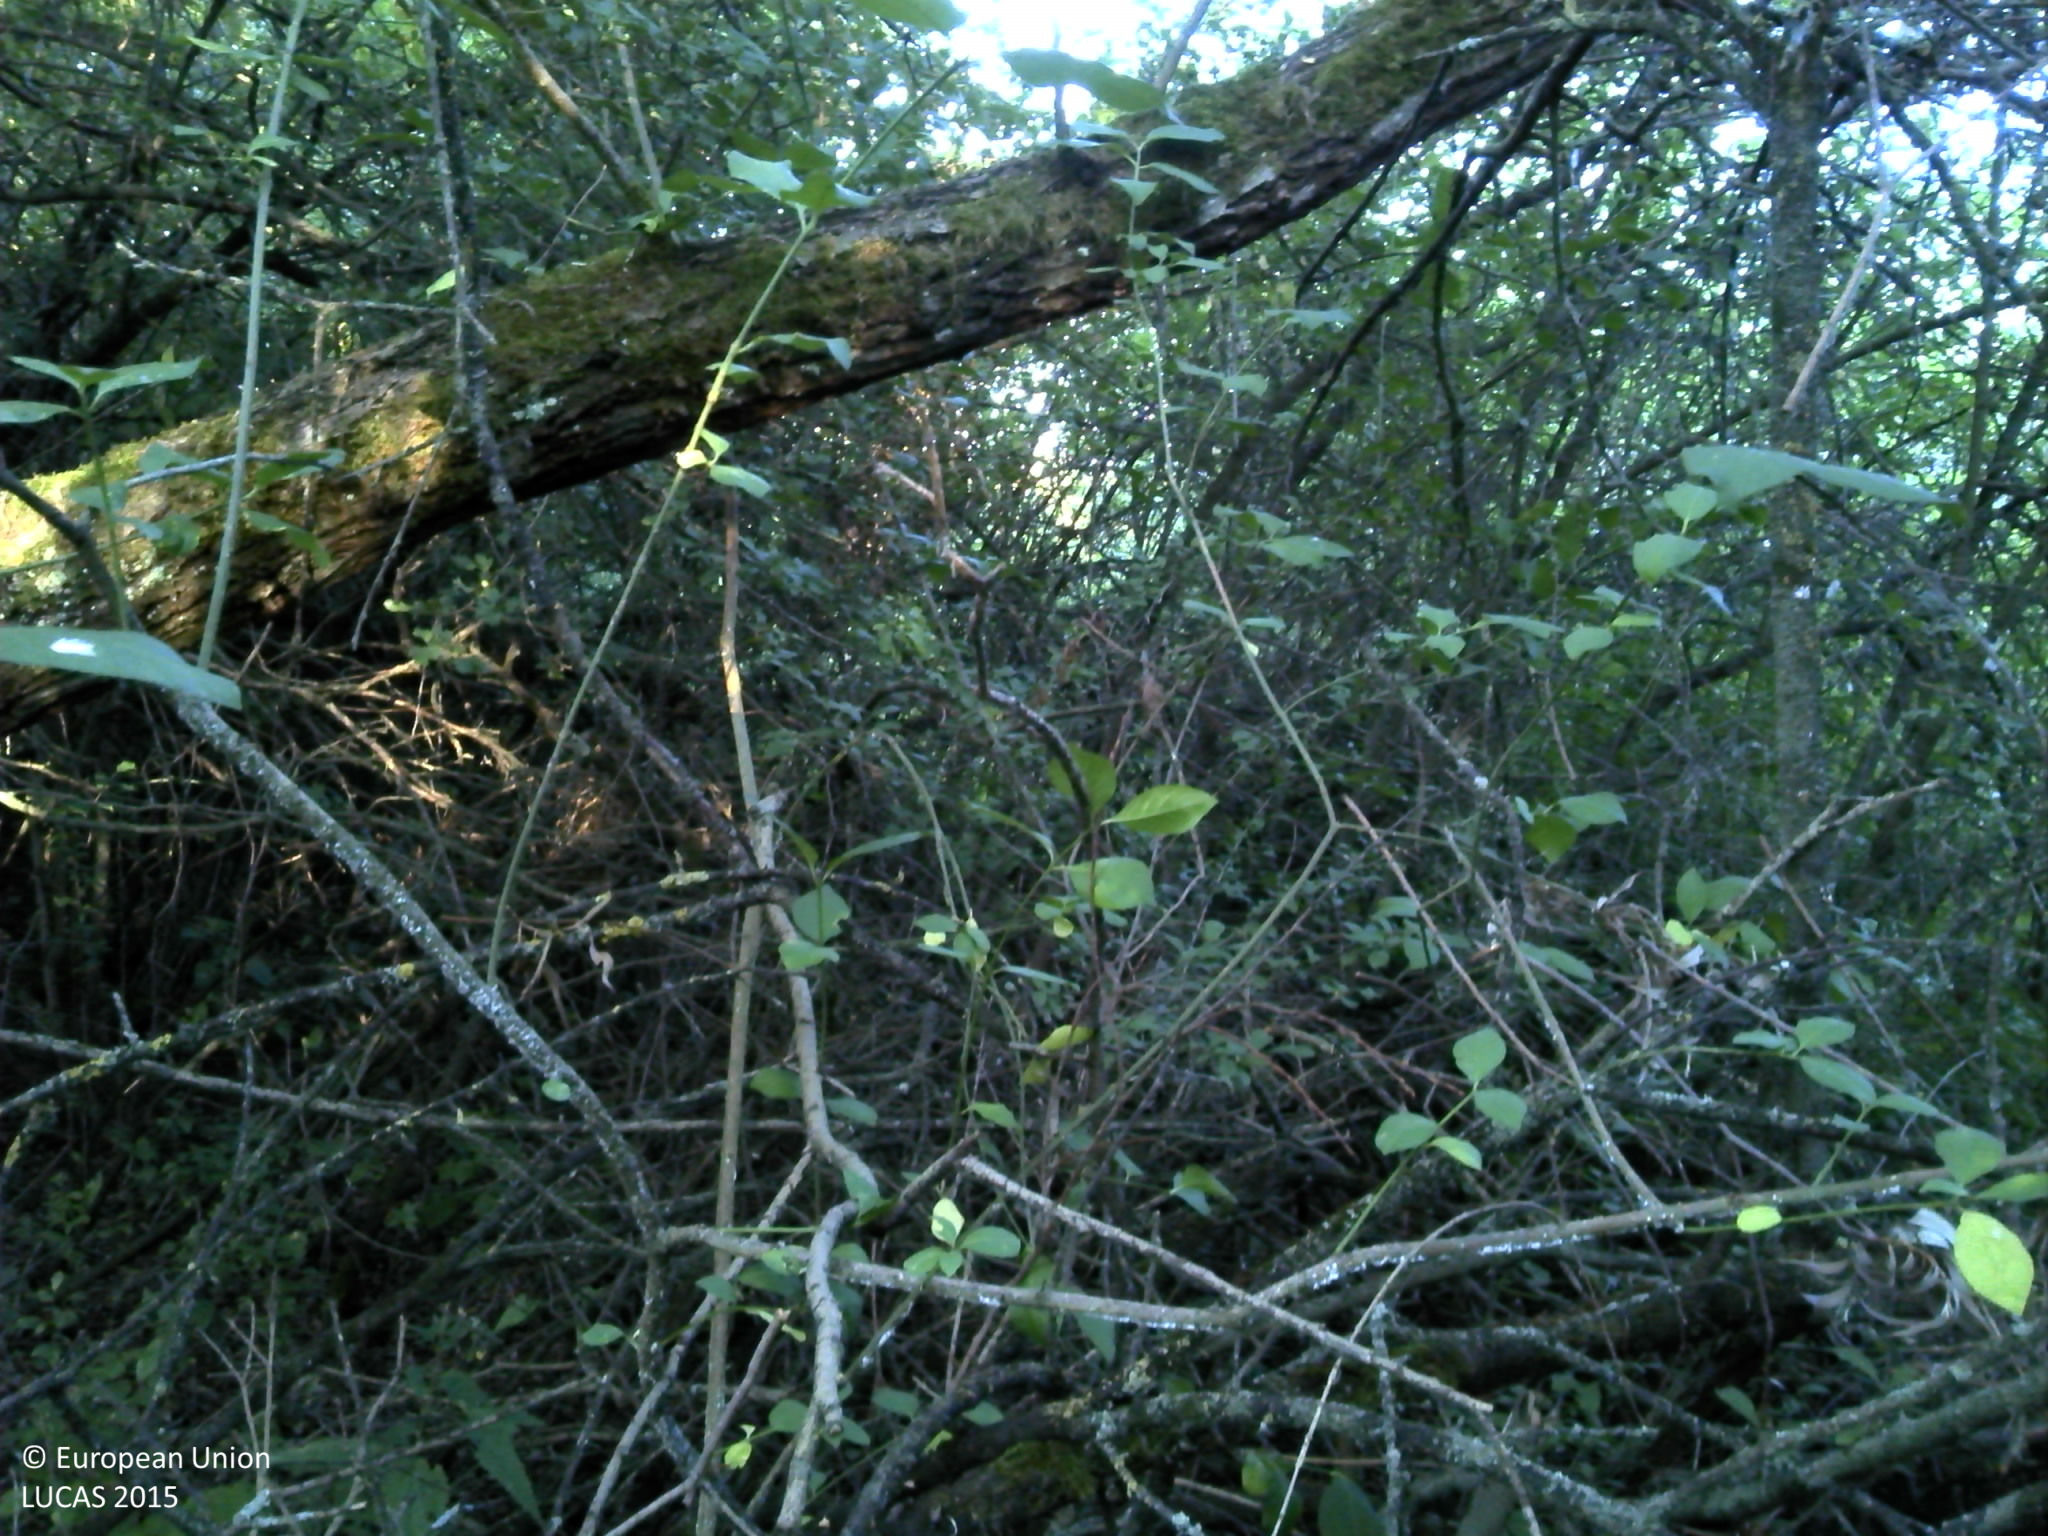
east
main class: Shrubland
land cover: Shrubland with sparse tree cover
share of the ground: > 75 %
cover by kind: shrubs 95 %, broadleaved forest trees 5 %
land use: Semi-natural and natural areas not in use
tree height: < 5 m
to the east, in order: Shrubland with sparse tree cover; Grassland with sparse tree/shrub cover; Shrubland with sparse tree cover; Grassland without tree/shrub cover; Shrubland with sparse tree cover; Grassland without tree/shrub cover
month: July
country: HR
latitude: 45.3915
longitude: 16.8324
